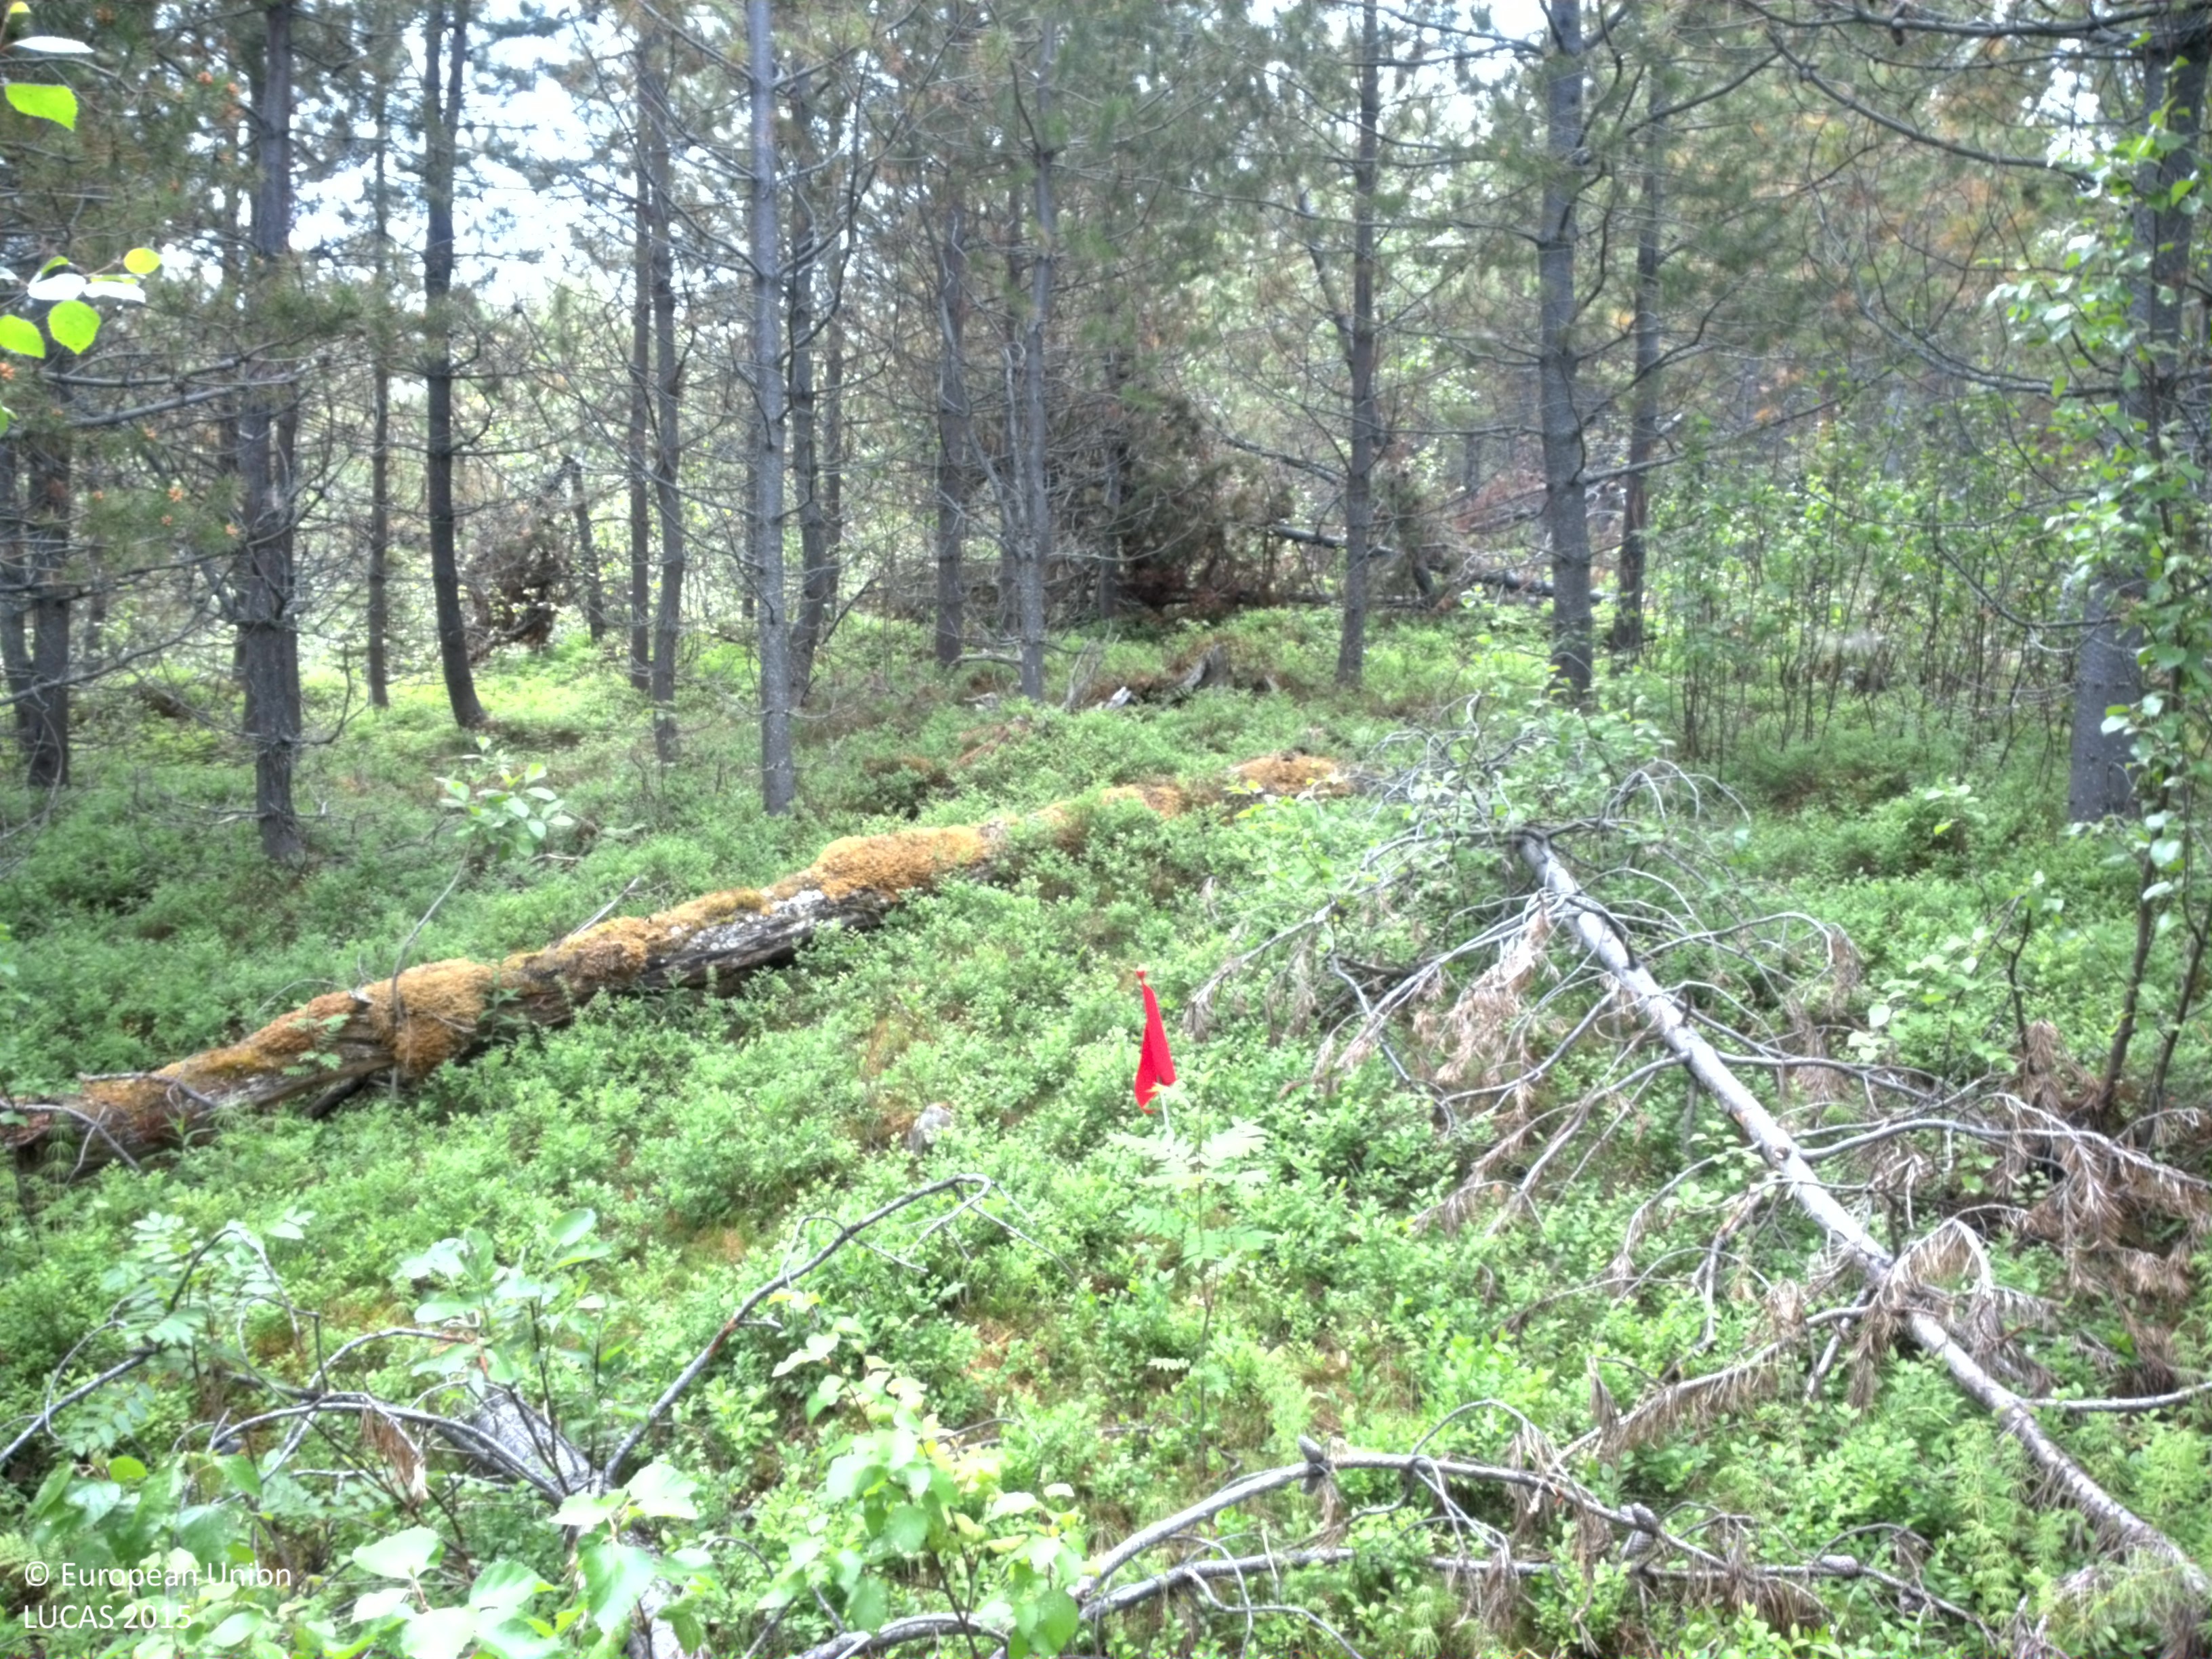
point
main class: Woodland
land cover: Pine dominated coniferous woodland
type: exotic forest
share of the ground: 50 - 75 %
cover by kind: coniferous forest trees 65 %, broadleaved forest trees 15 %, shrubs 15 %, herbaceous plants 5 %
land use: Forestry
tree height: > 5 m
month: July
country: SE
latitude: 64.4700
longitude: 17.9741
